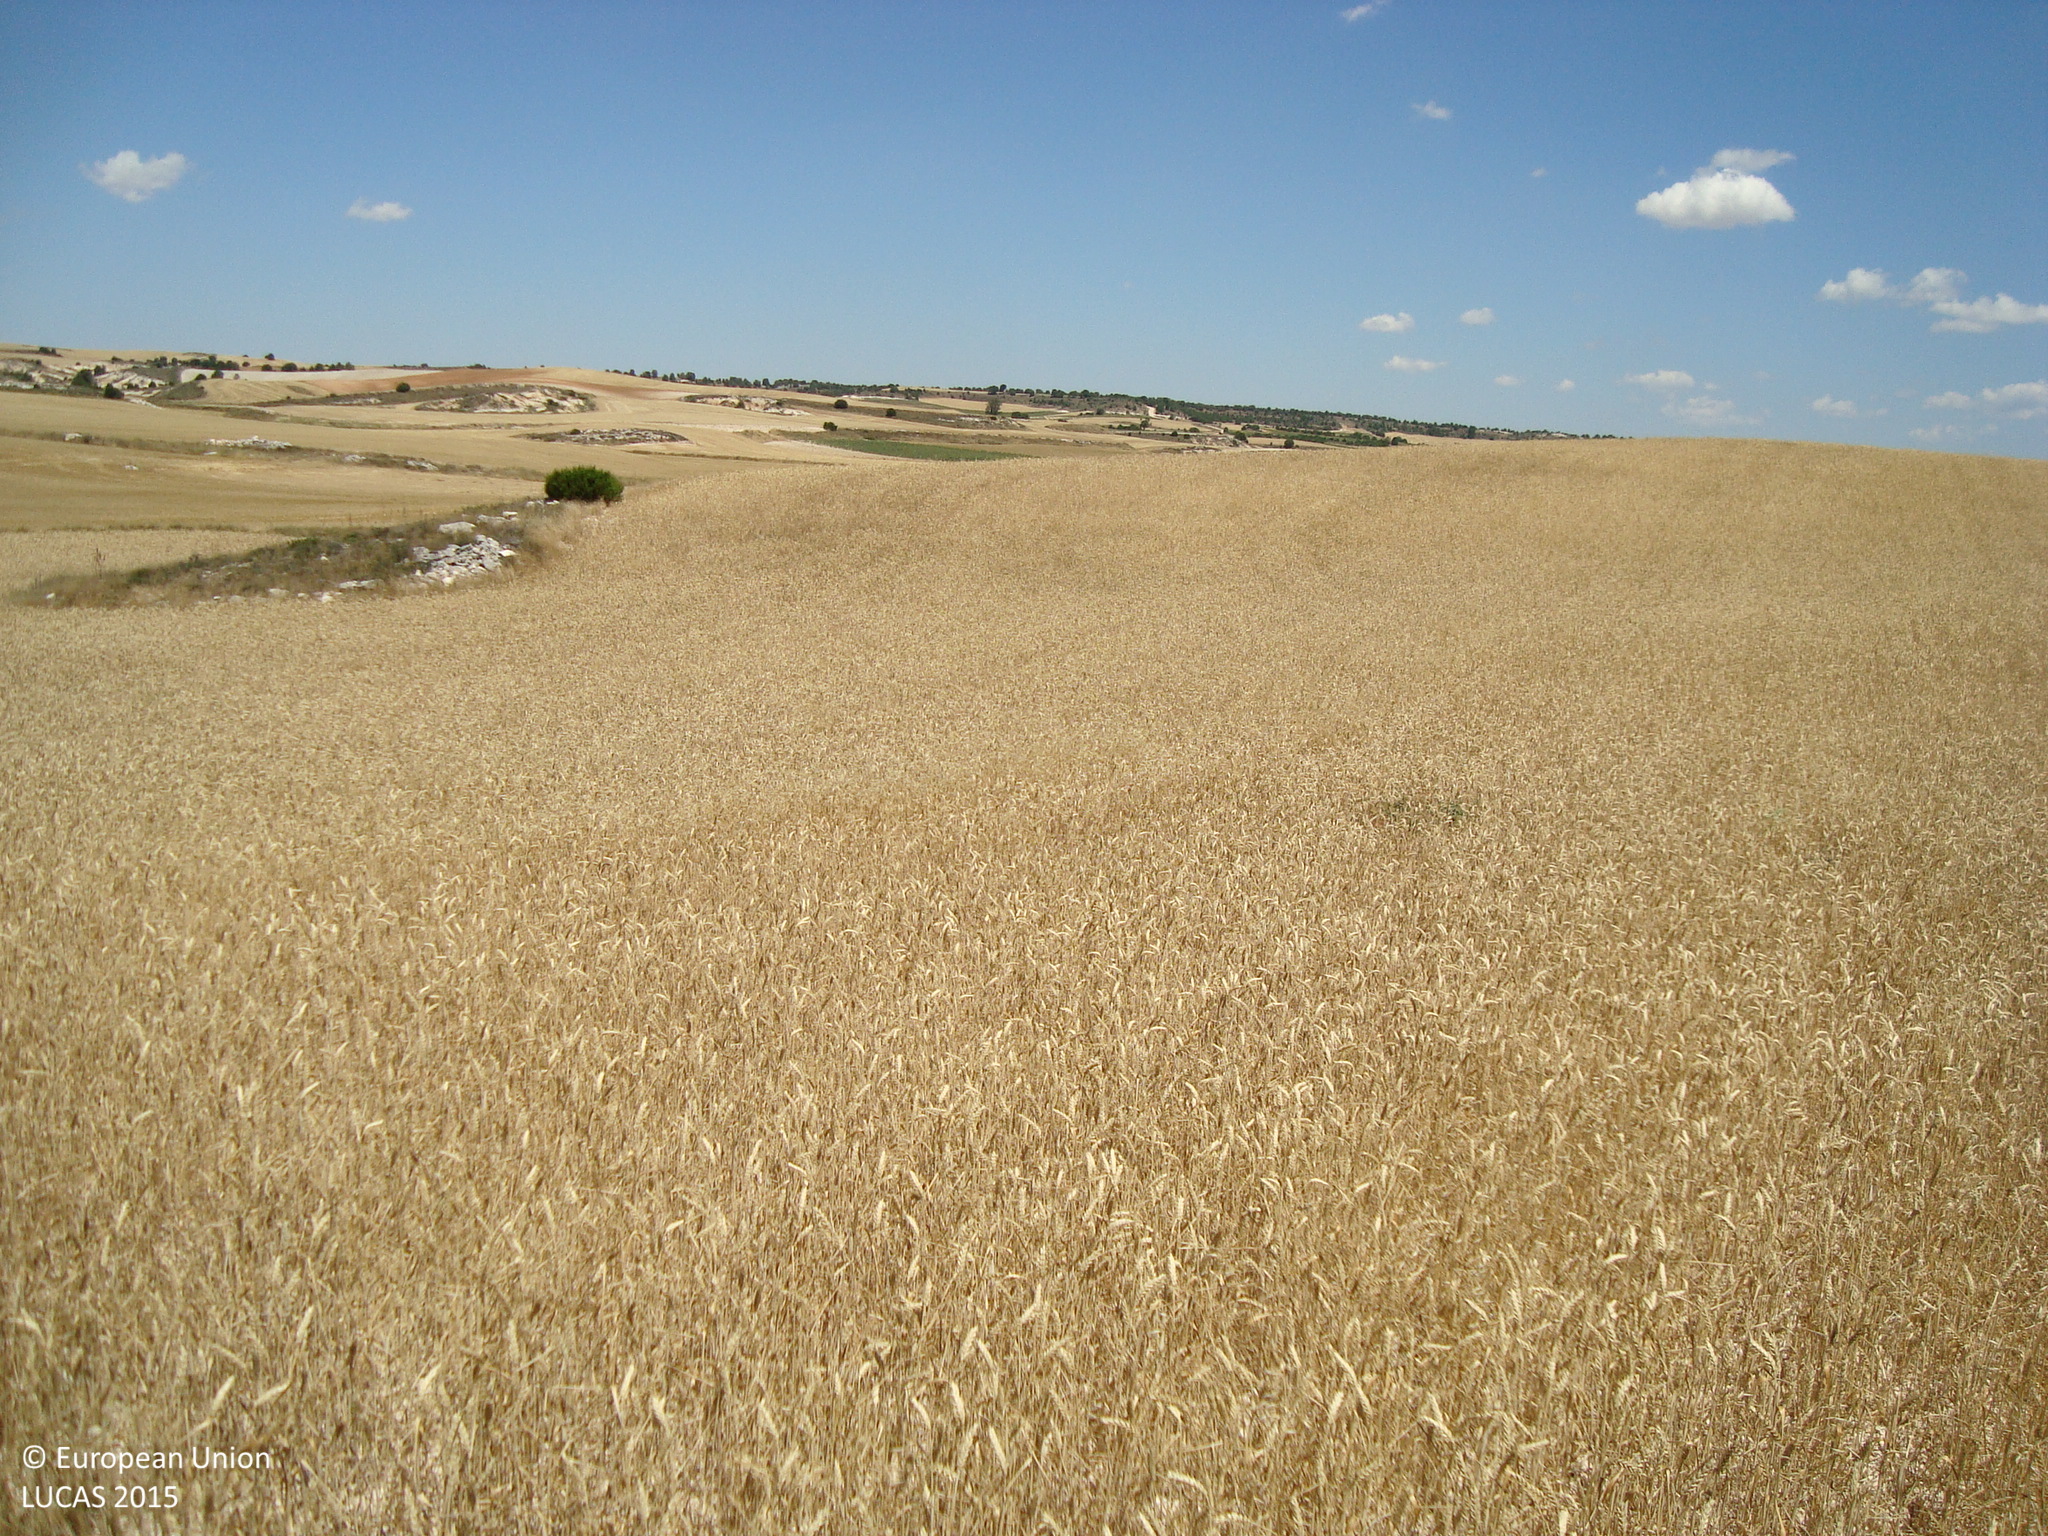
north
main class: Cropland
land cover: Common wheat
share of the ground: 50 - 75 %
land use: Agriculture (excluding fallow land and kitchen gardens)
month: July
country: ES
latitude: 41.8704
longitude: -3.6572
